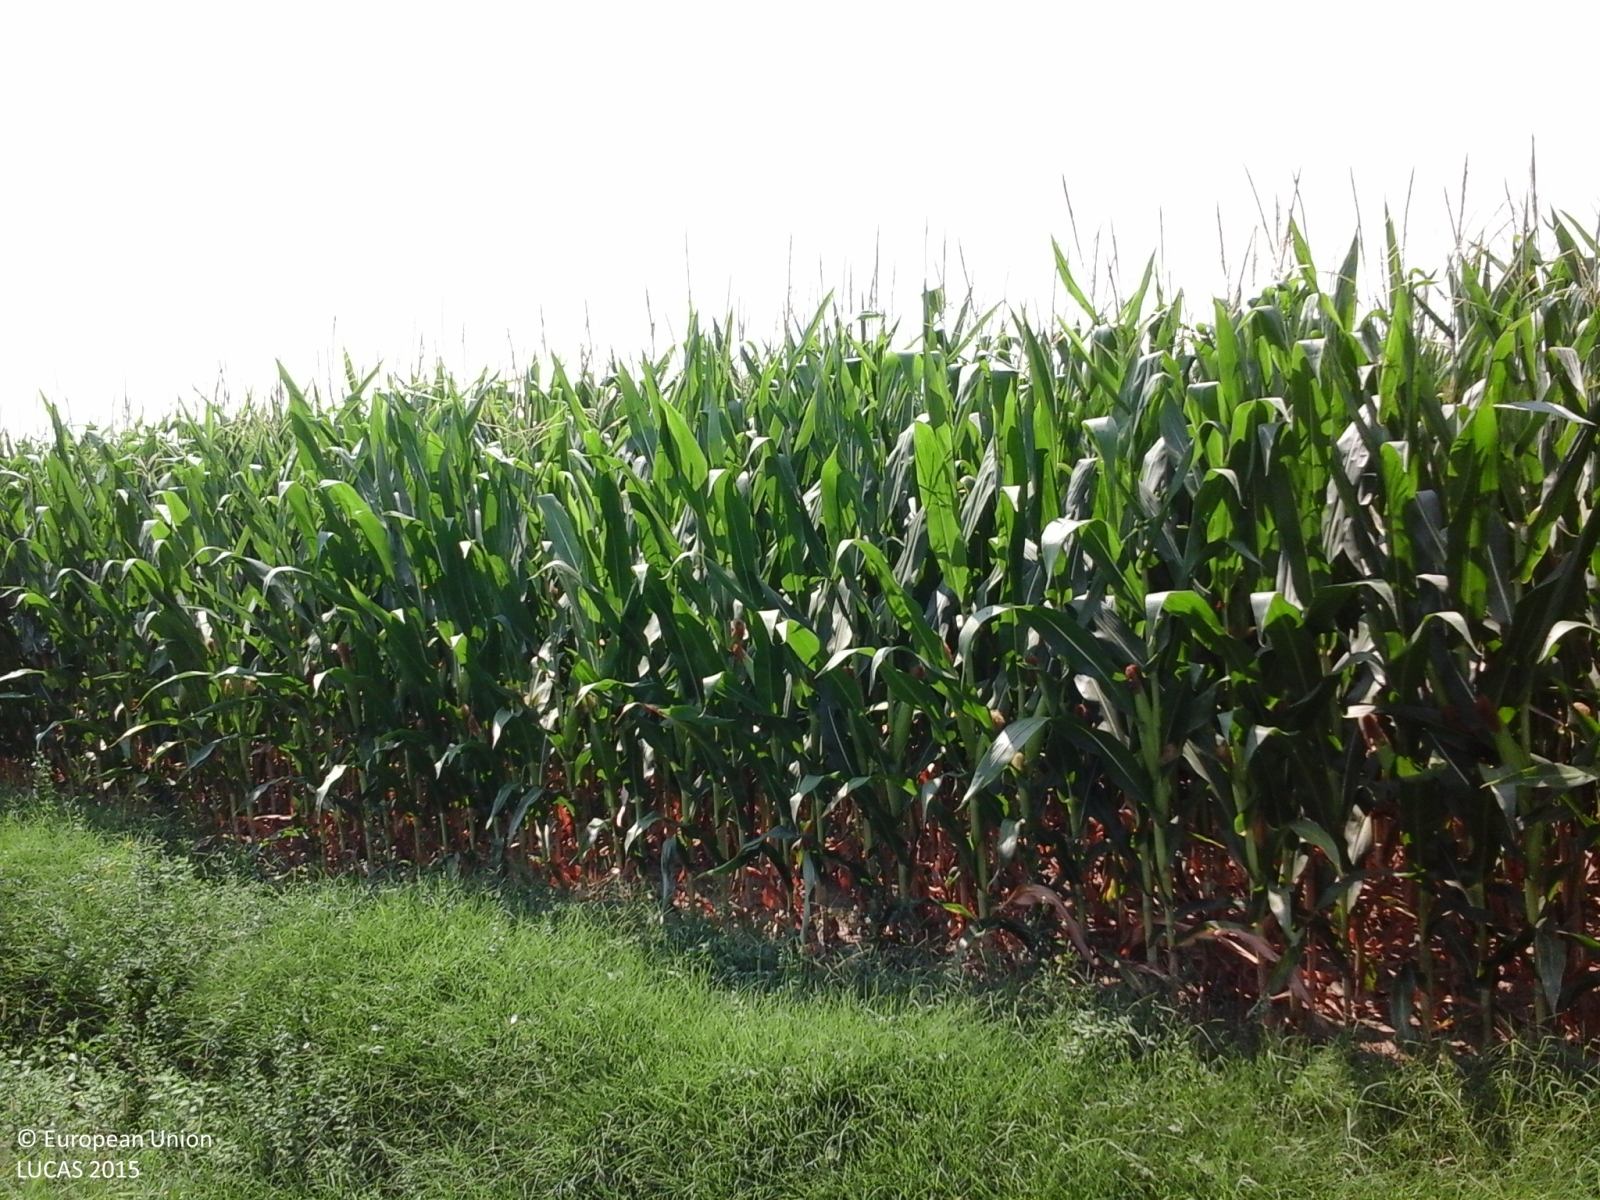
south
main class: Cropland
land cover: Maize
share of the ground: > 75 %
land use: Agriculture (excluding fallow land and kitchen gardens)
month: July
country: IT
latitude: 44.6261
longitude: 11.6477
